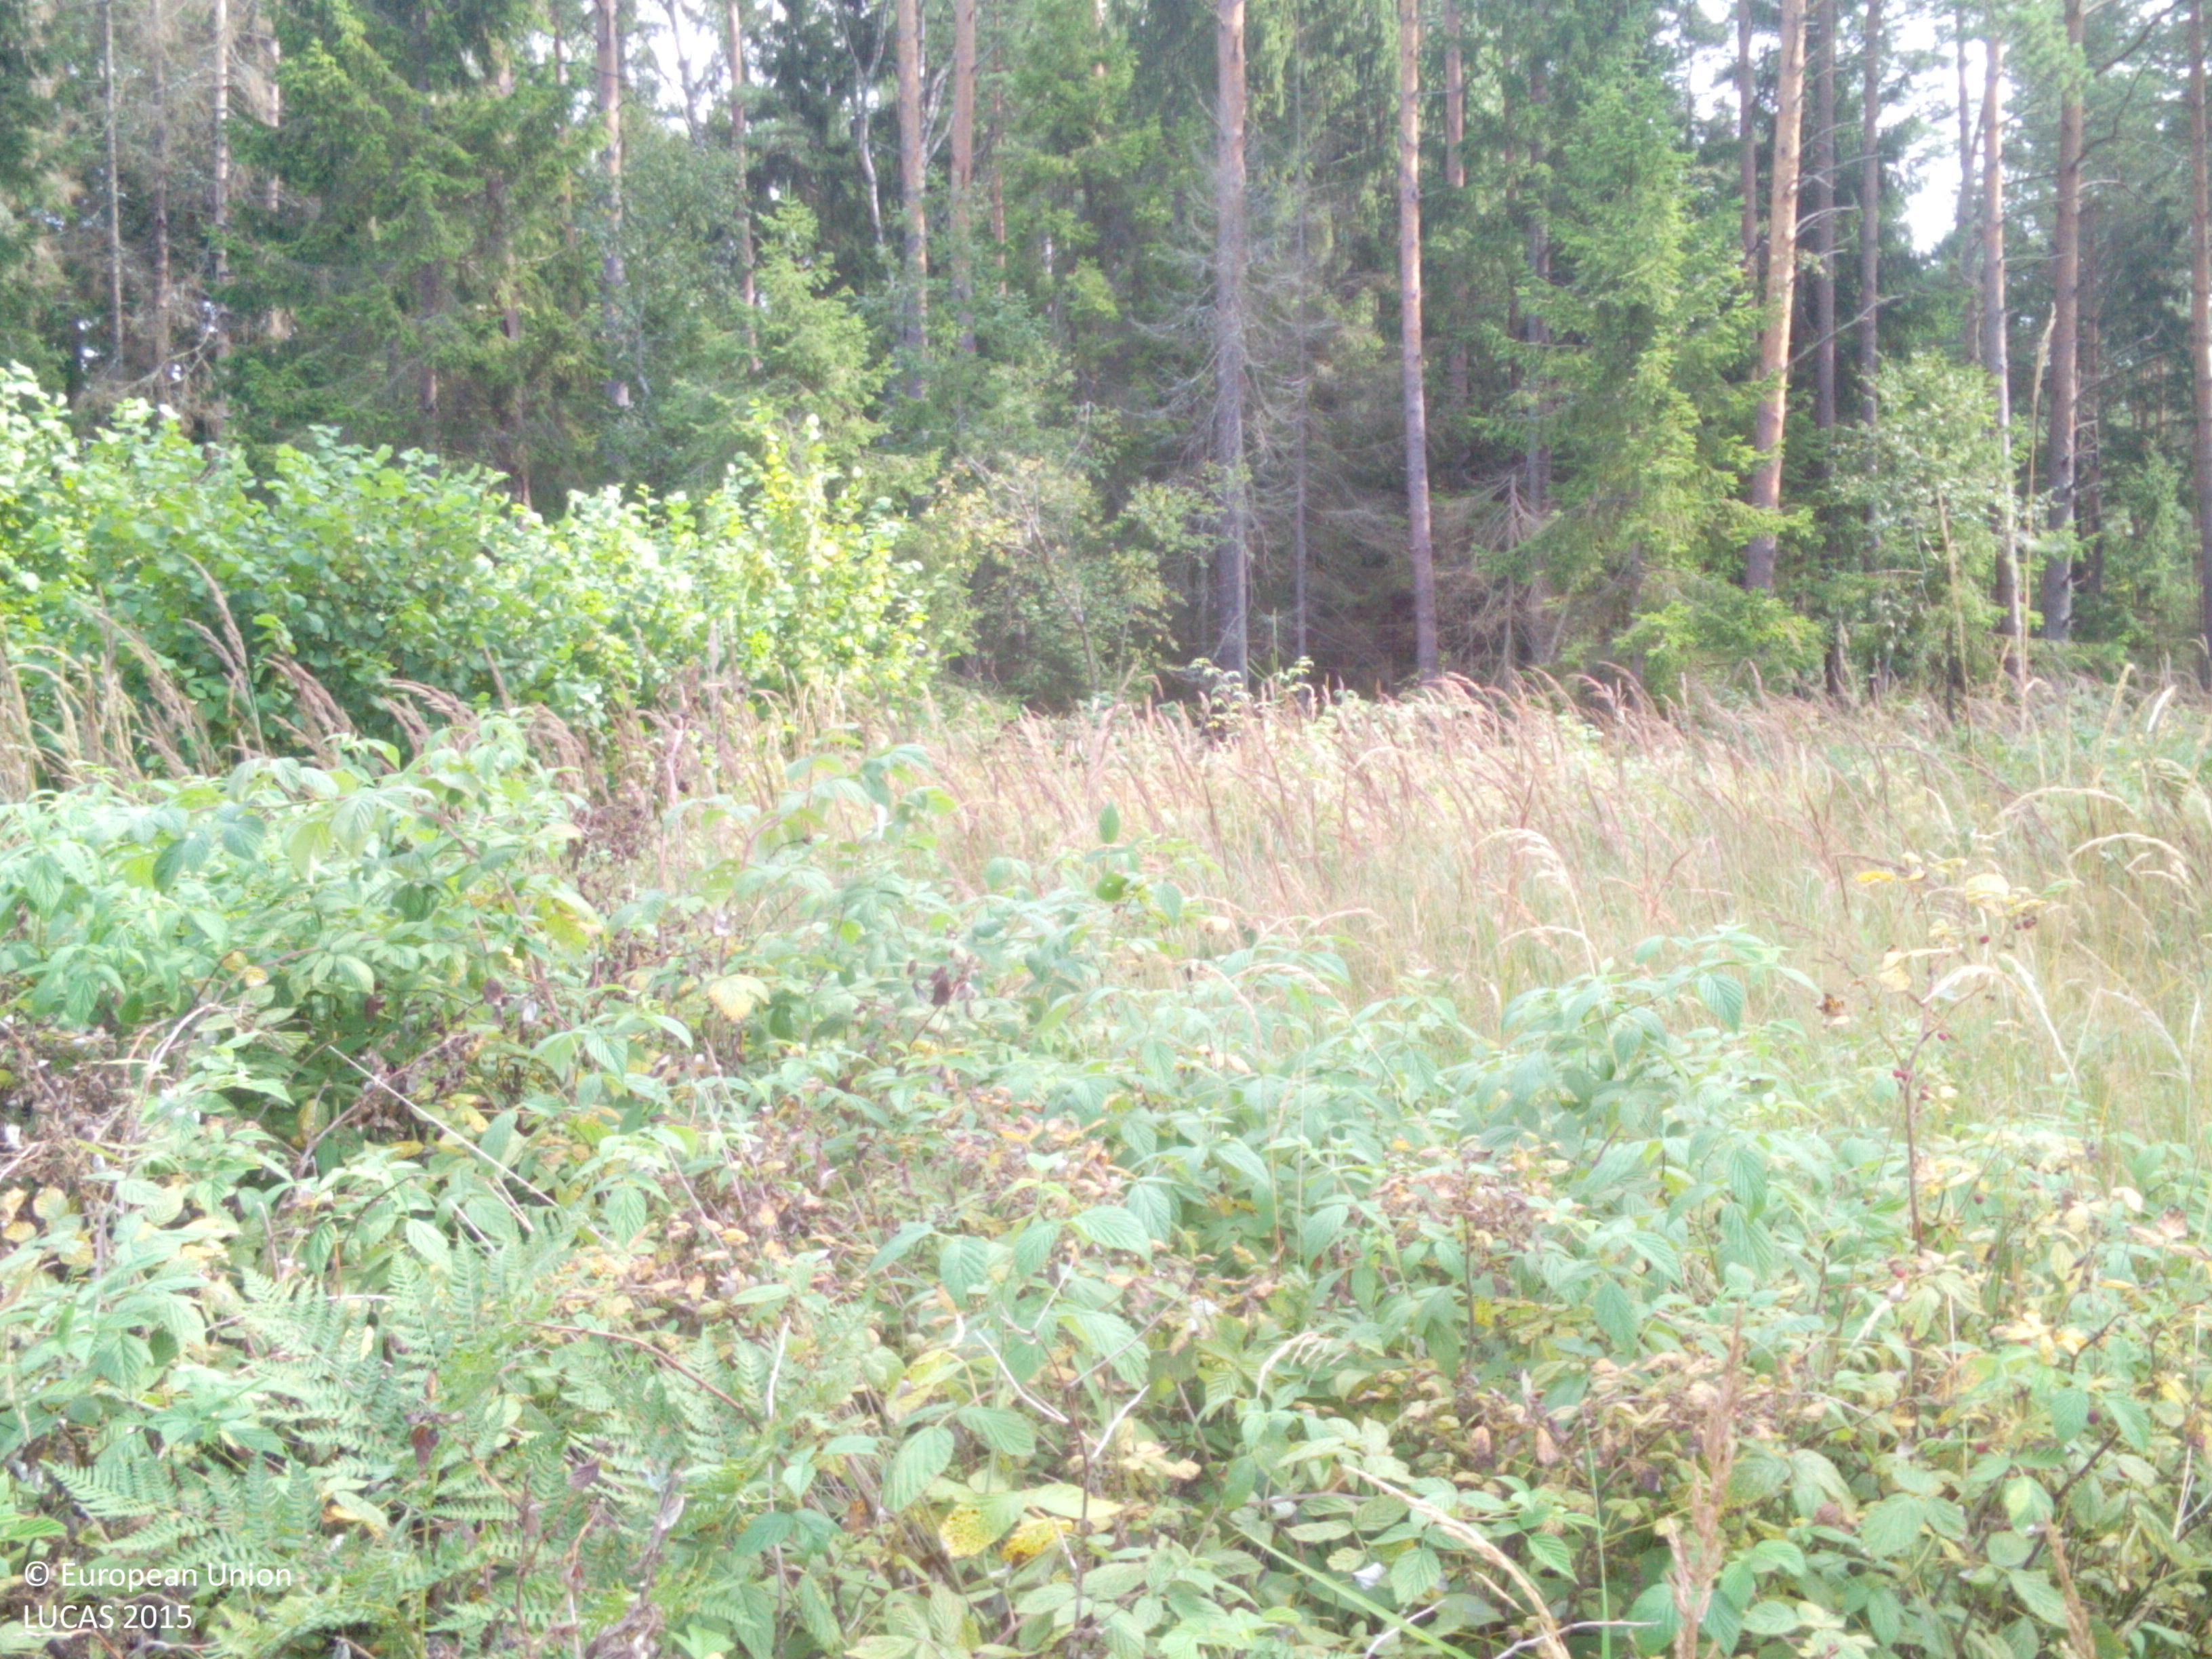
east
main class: Grassland
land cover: Grassland with sparse tree/shrub cover
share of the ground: > 75 %
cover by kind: herbaceous plants 85 %, shrubs 10 %, broadleaved forest trees 5 %
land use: Forestry
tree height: < 5 m
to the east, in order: Grassland with sparse tree/shrub cover; Other coniferous woodland; Tracks; Pine dominated coniferous woodland; Paved roads, cycling and walking lanes; Spontaneously vegetated surfaces
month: August
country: LV
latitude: 56.3305
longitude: 21.2147
